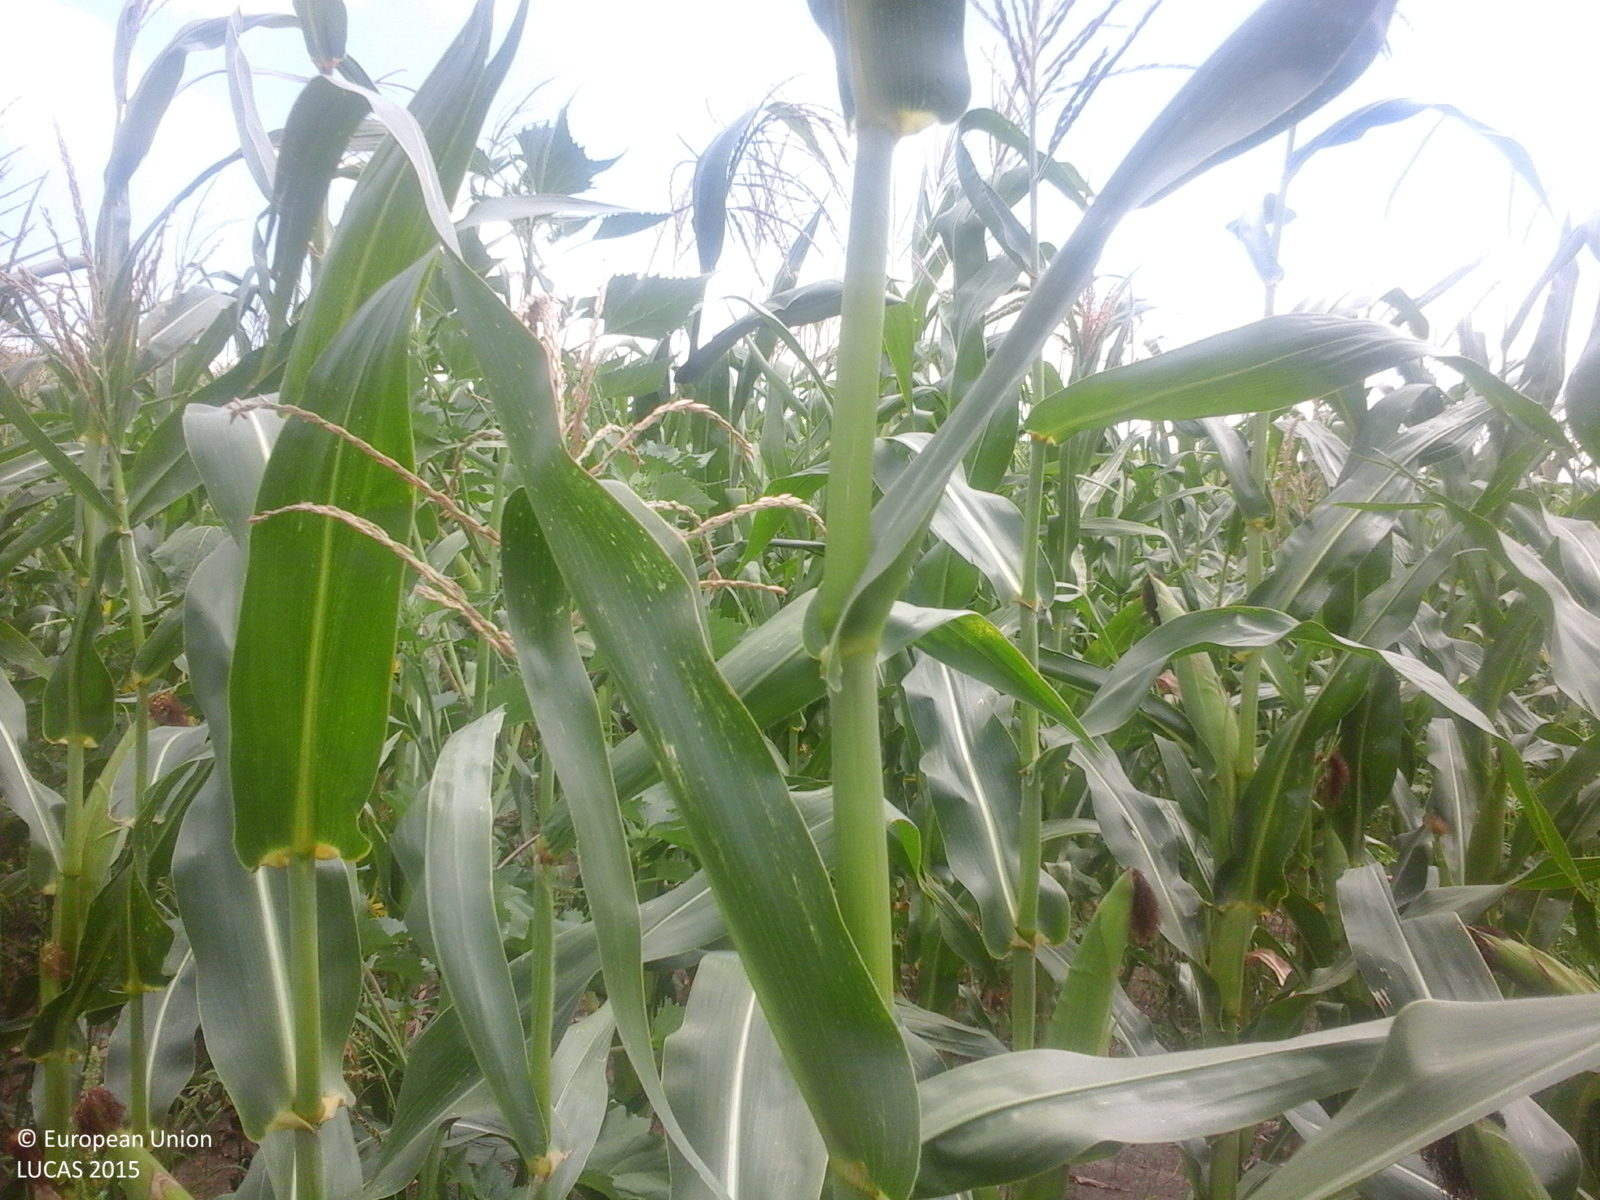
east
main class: Cropland
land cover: Maize
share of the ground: > 75 %
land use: Agriculture (excluding fallow land and kitchen gardens)
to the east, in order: Maize; Sunflower
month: July
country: RO
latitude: 46.5227
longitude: 27.9985
